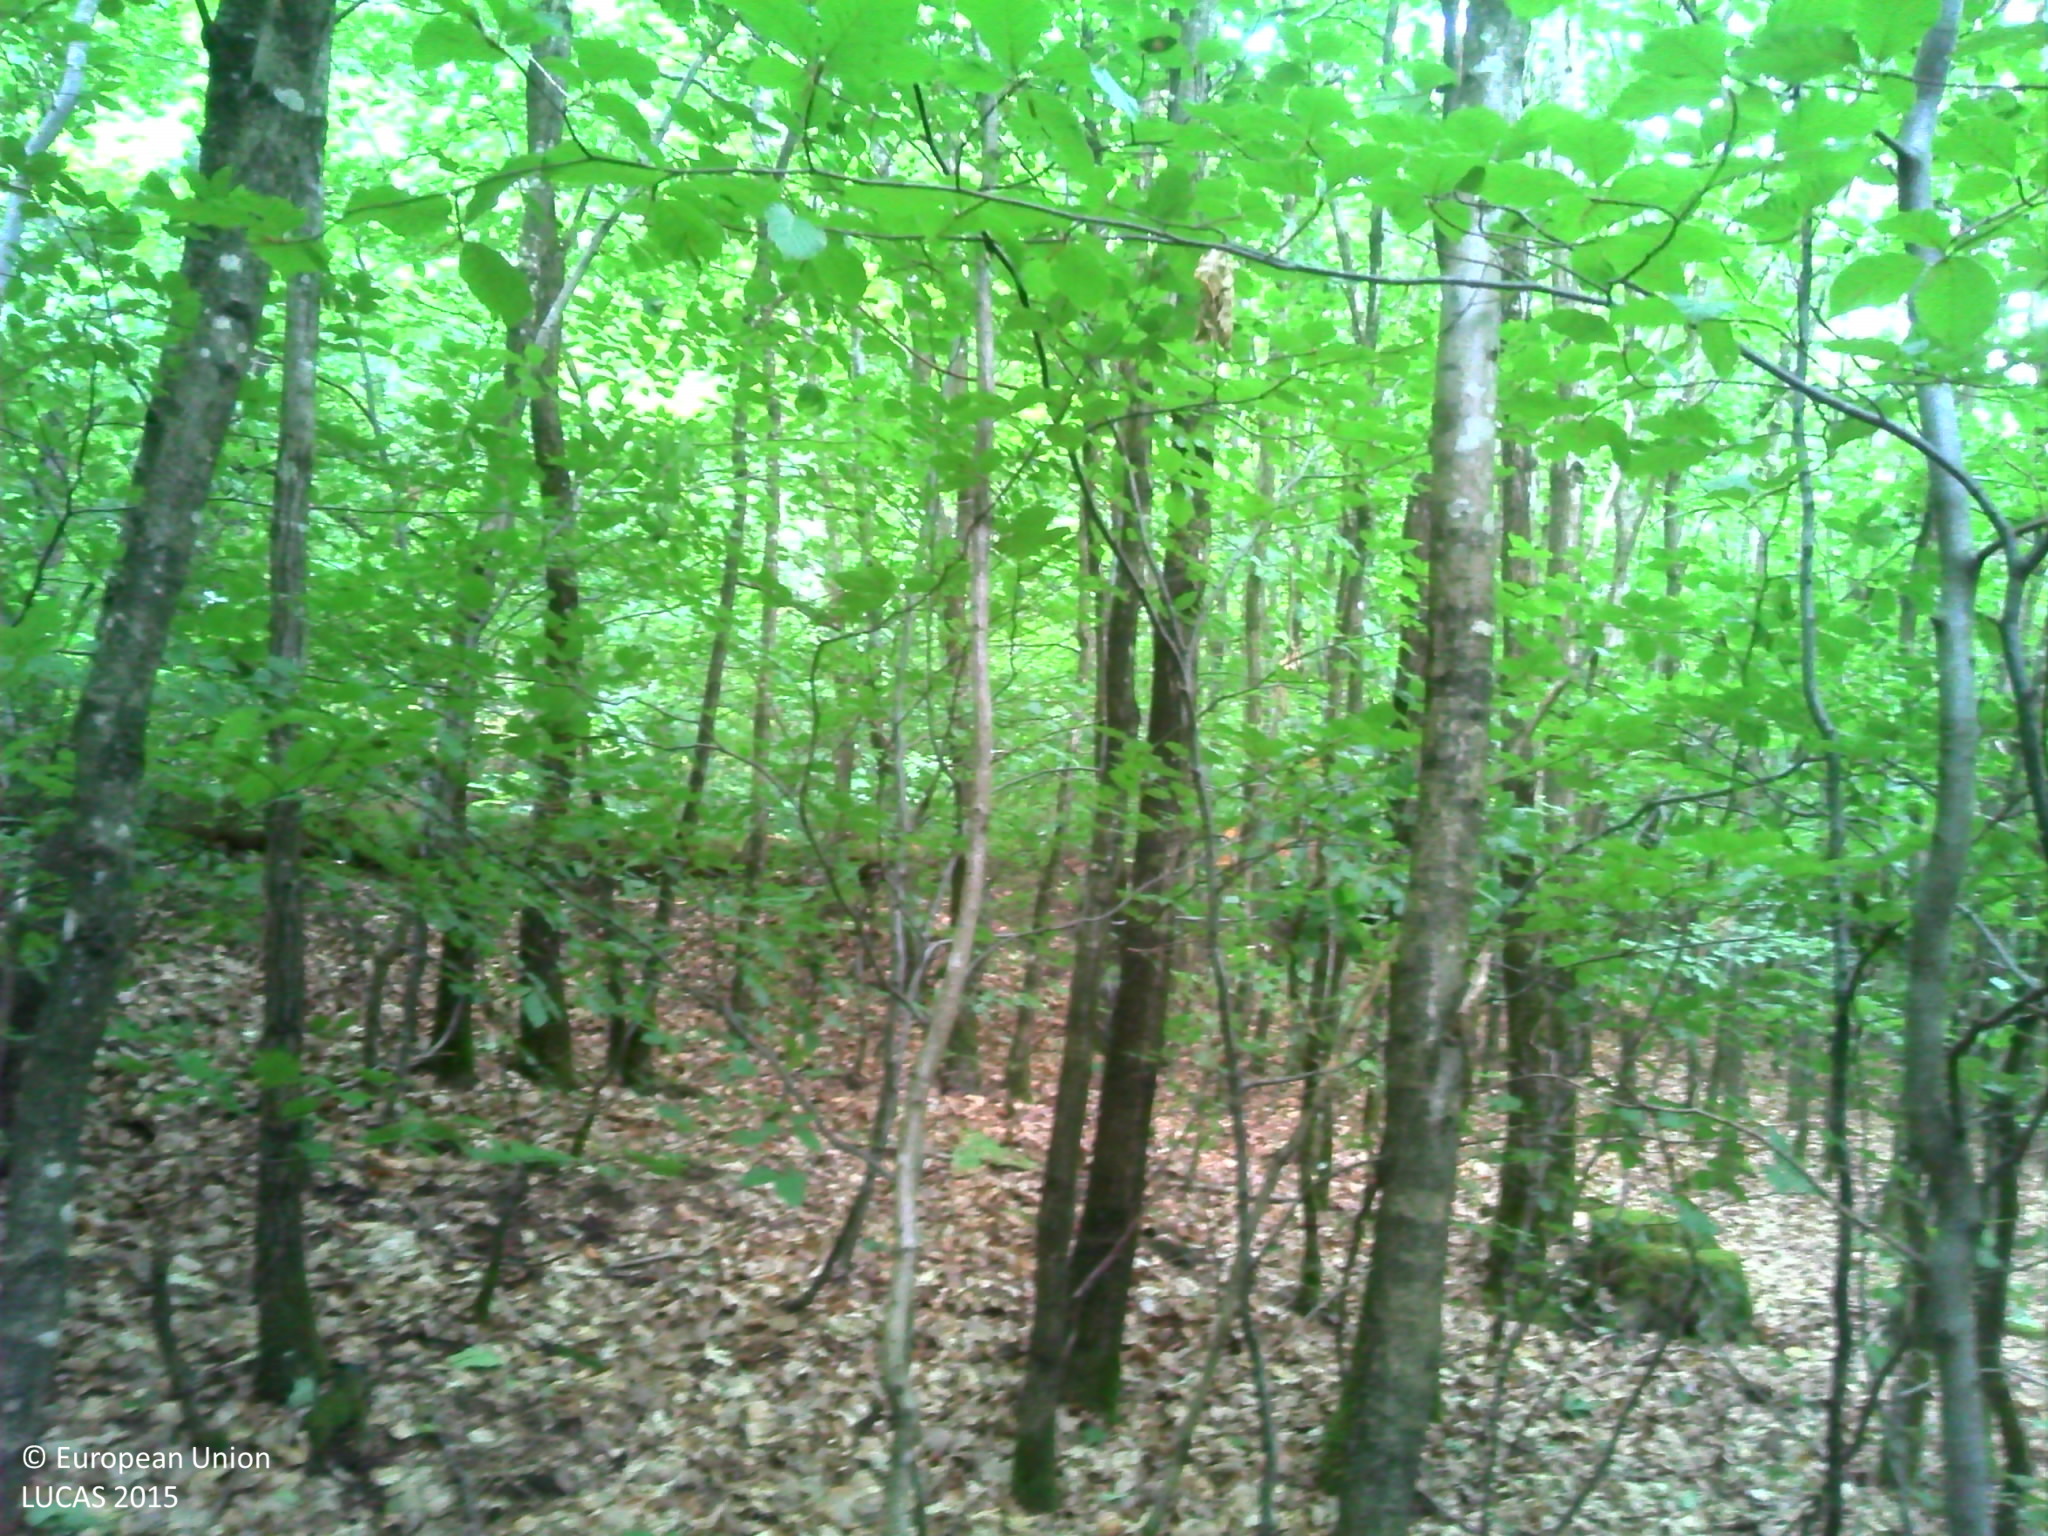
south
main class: Woodland
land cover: Broadleaved woodland
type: beech forest
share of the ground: > 75 %
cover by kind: broadleaved forest trees 100 %
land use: Forestry
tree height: > 5 m
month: July
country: FR
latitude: 48.9339
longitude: 7.5298
